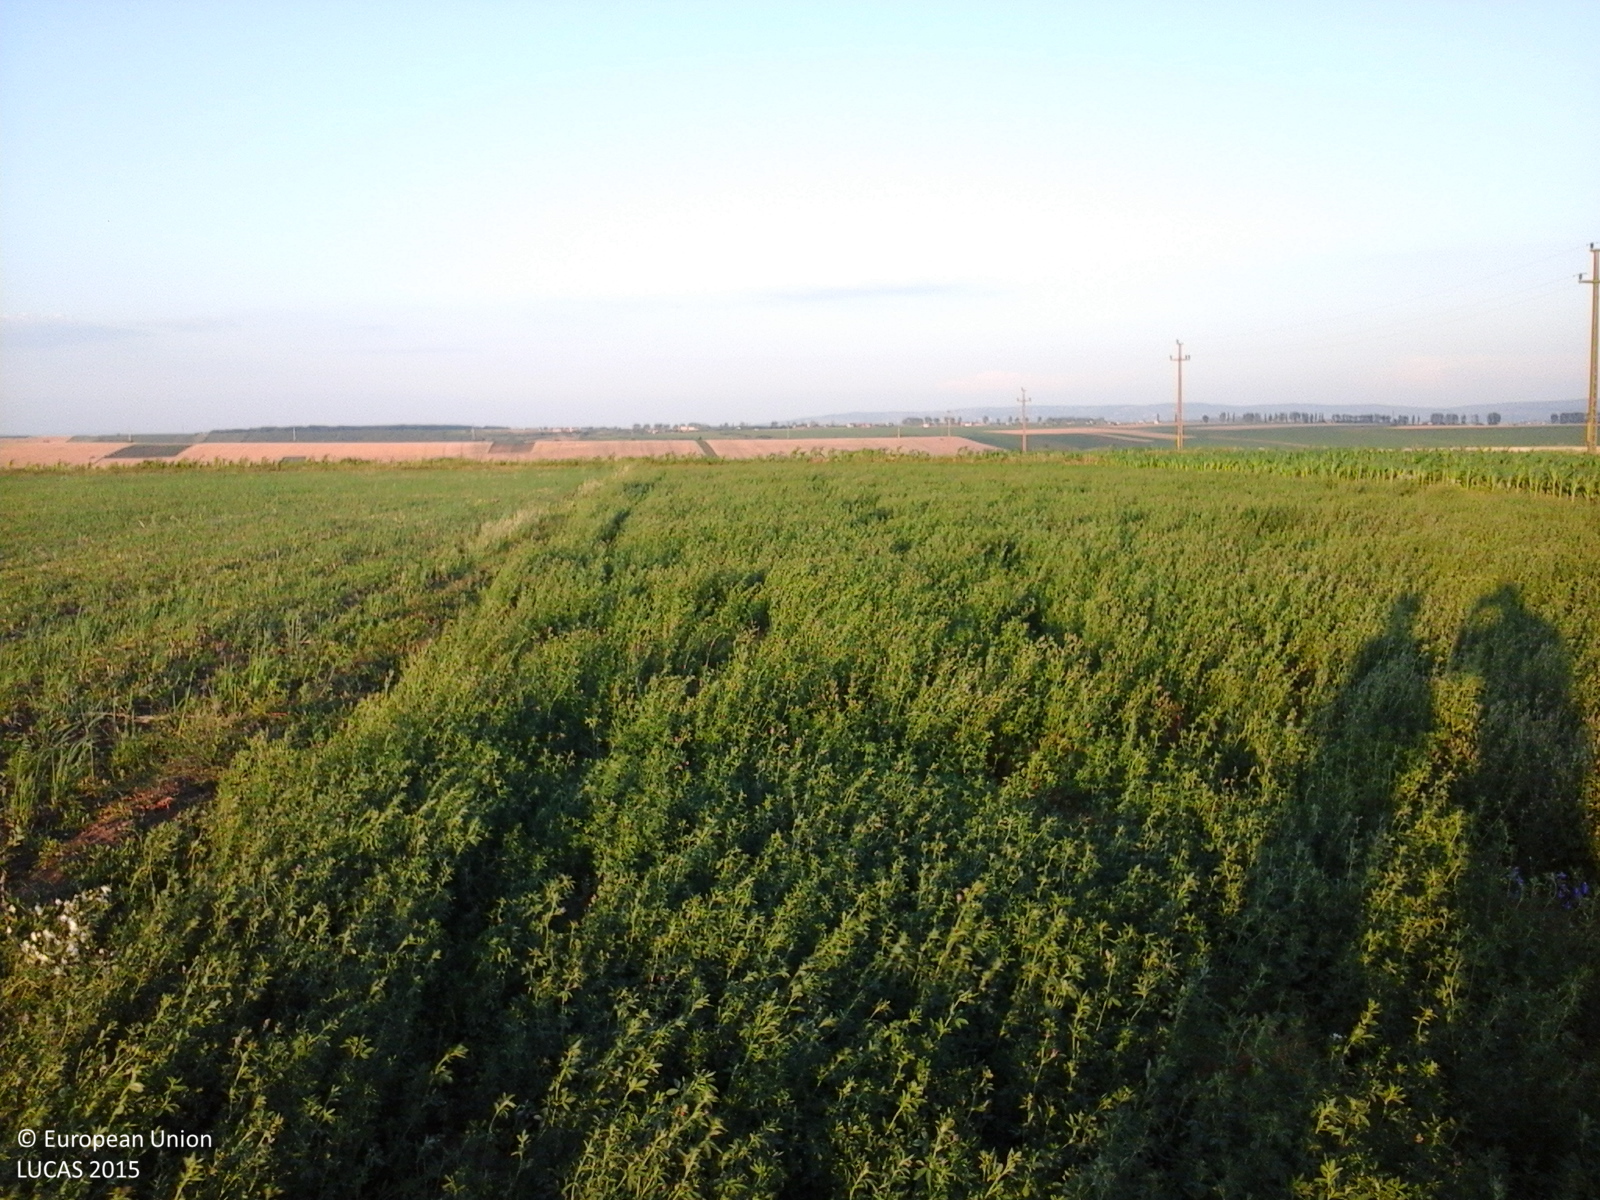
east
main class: Cropland
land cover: Lucerne
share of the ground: > 75 %
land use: Agriculture (excluding fallow land and kitchen gardens)
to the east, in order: Lucerne; Tracks; Grass margins; Maize; Spontaneously vegetated surfaces; Maize; Shrubland with sparse tree cover; Spontaneously vegetated surfaces; Tracks; Spontaneously vegetated surfaces
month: June
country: RO
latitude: 47.1343
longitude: 27.4241
